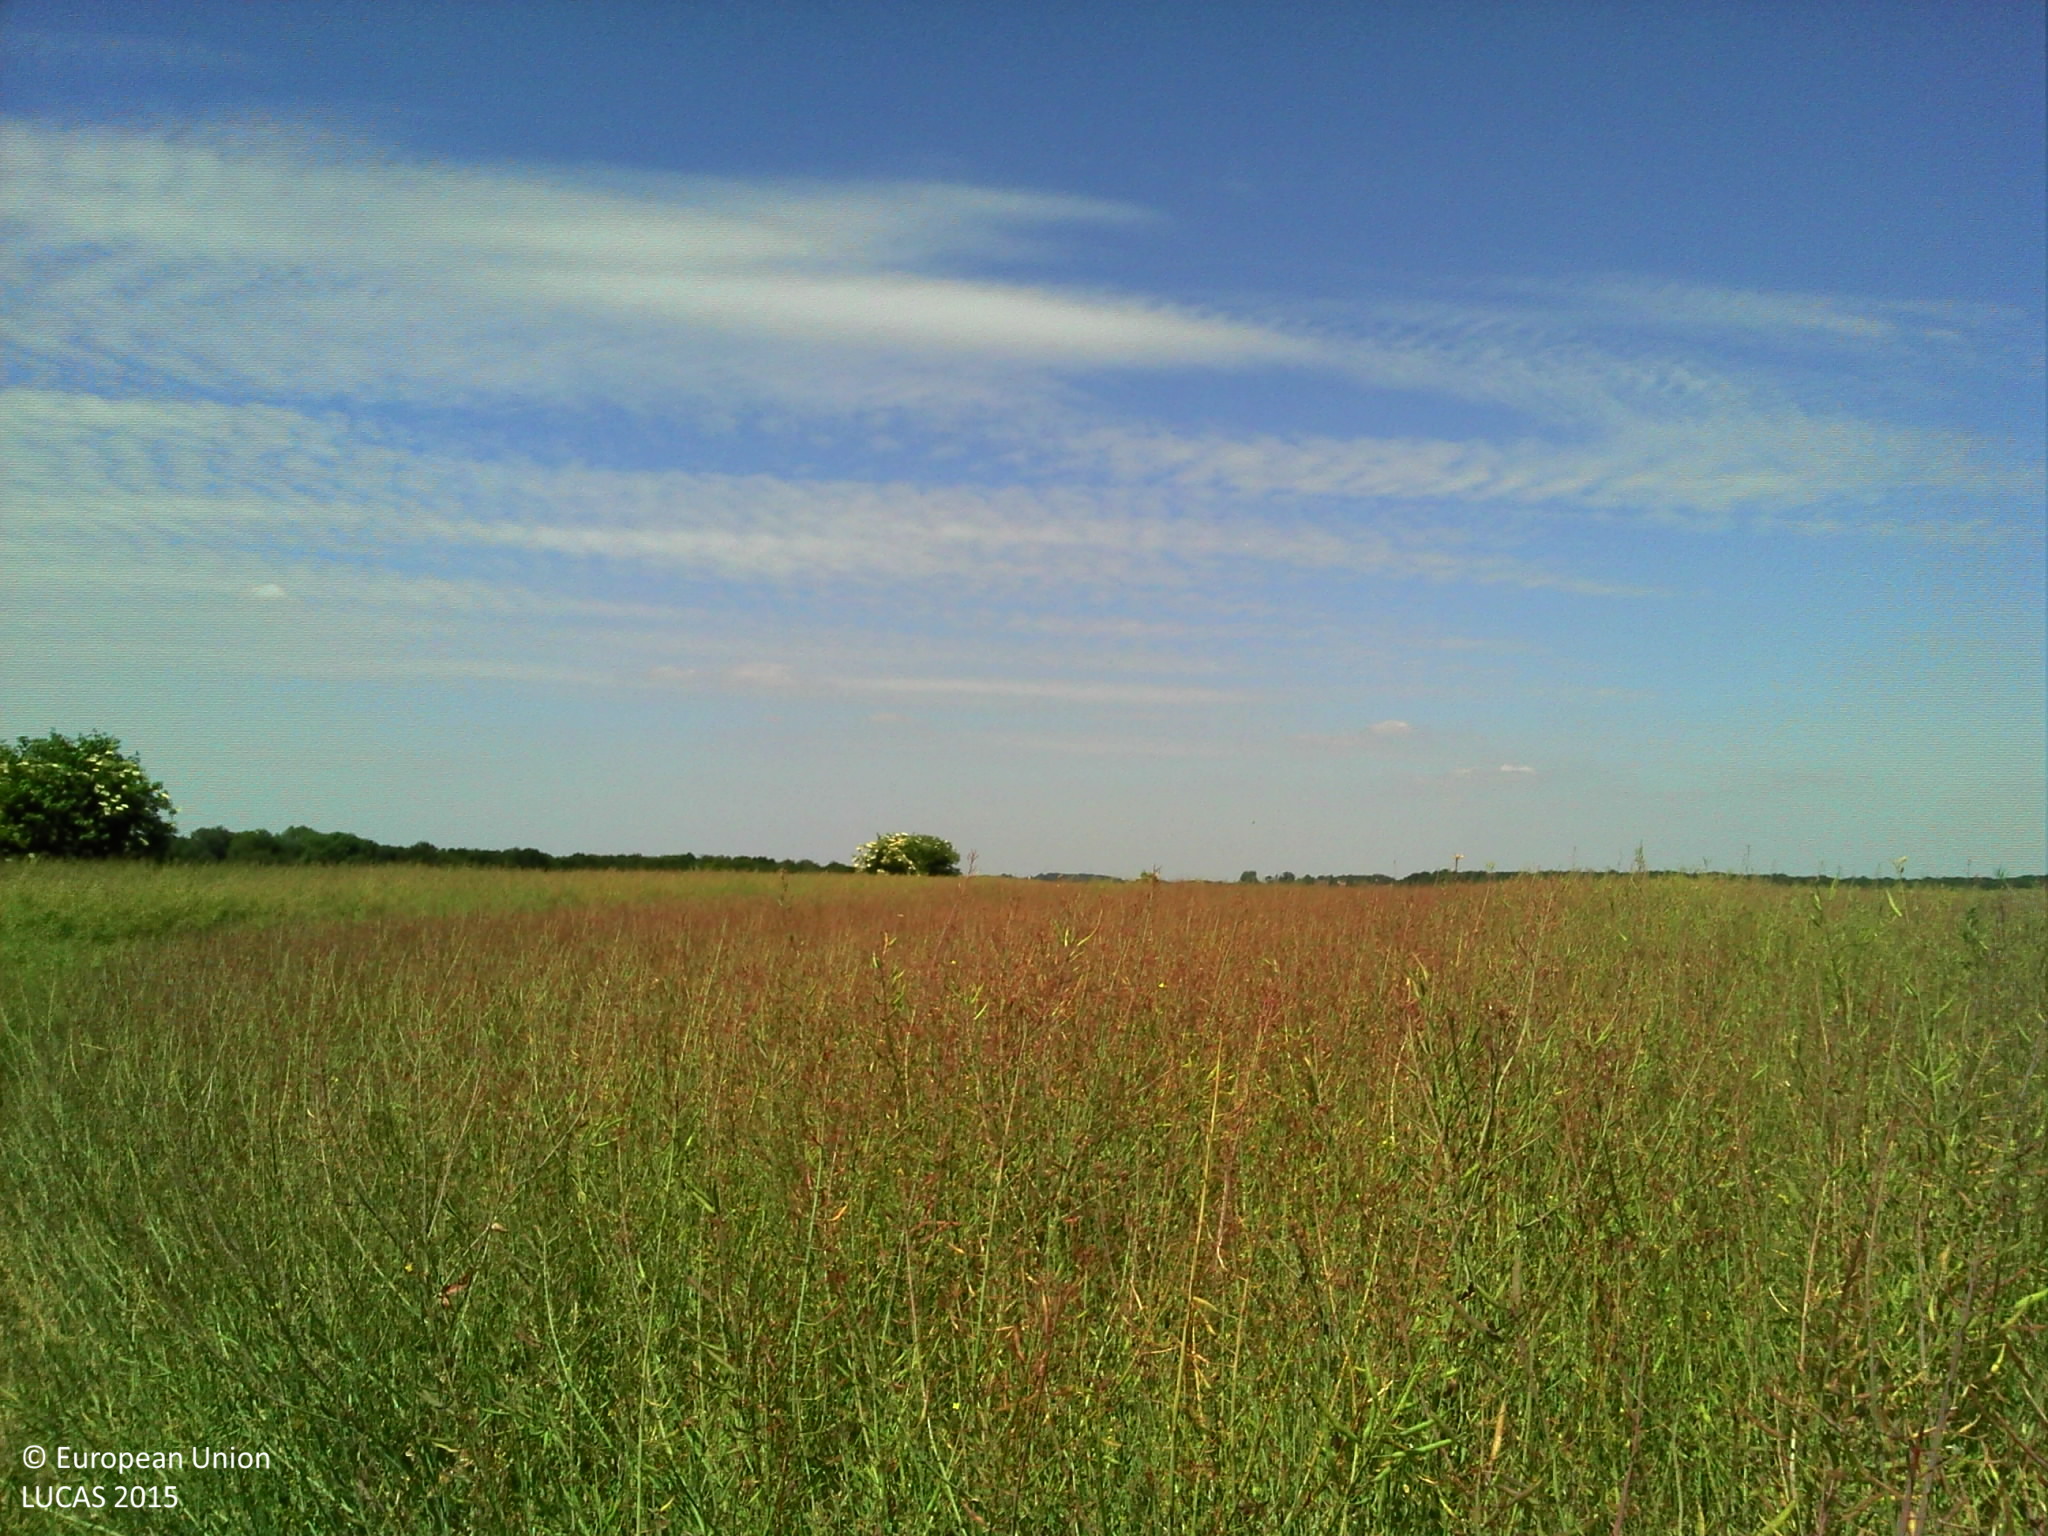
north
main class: Cropland
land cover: Rape and turnip rape
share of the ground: > 75 %
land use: Agriculture (excluding fallow land and kitchen gardens)
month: June
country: FR
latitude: 49.5065
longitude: 2.5447
